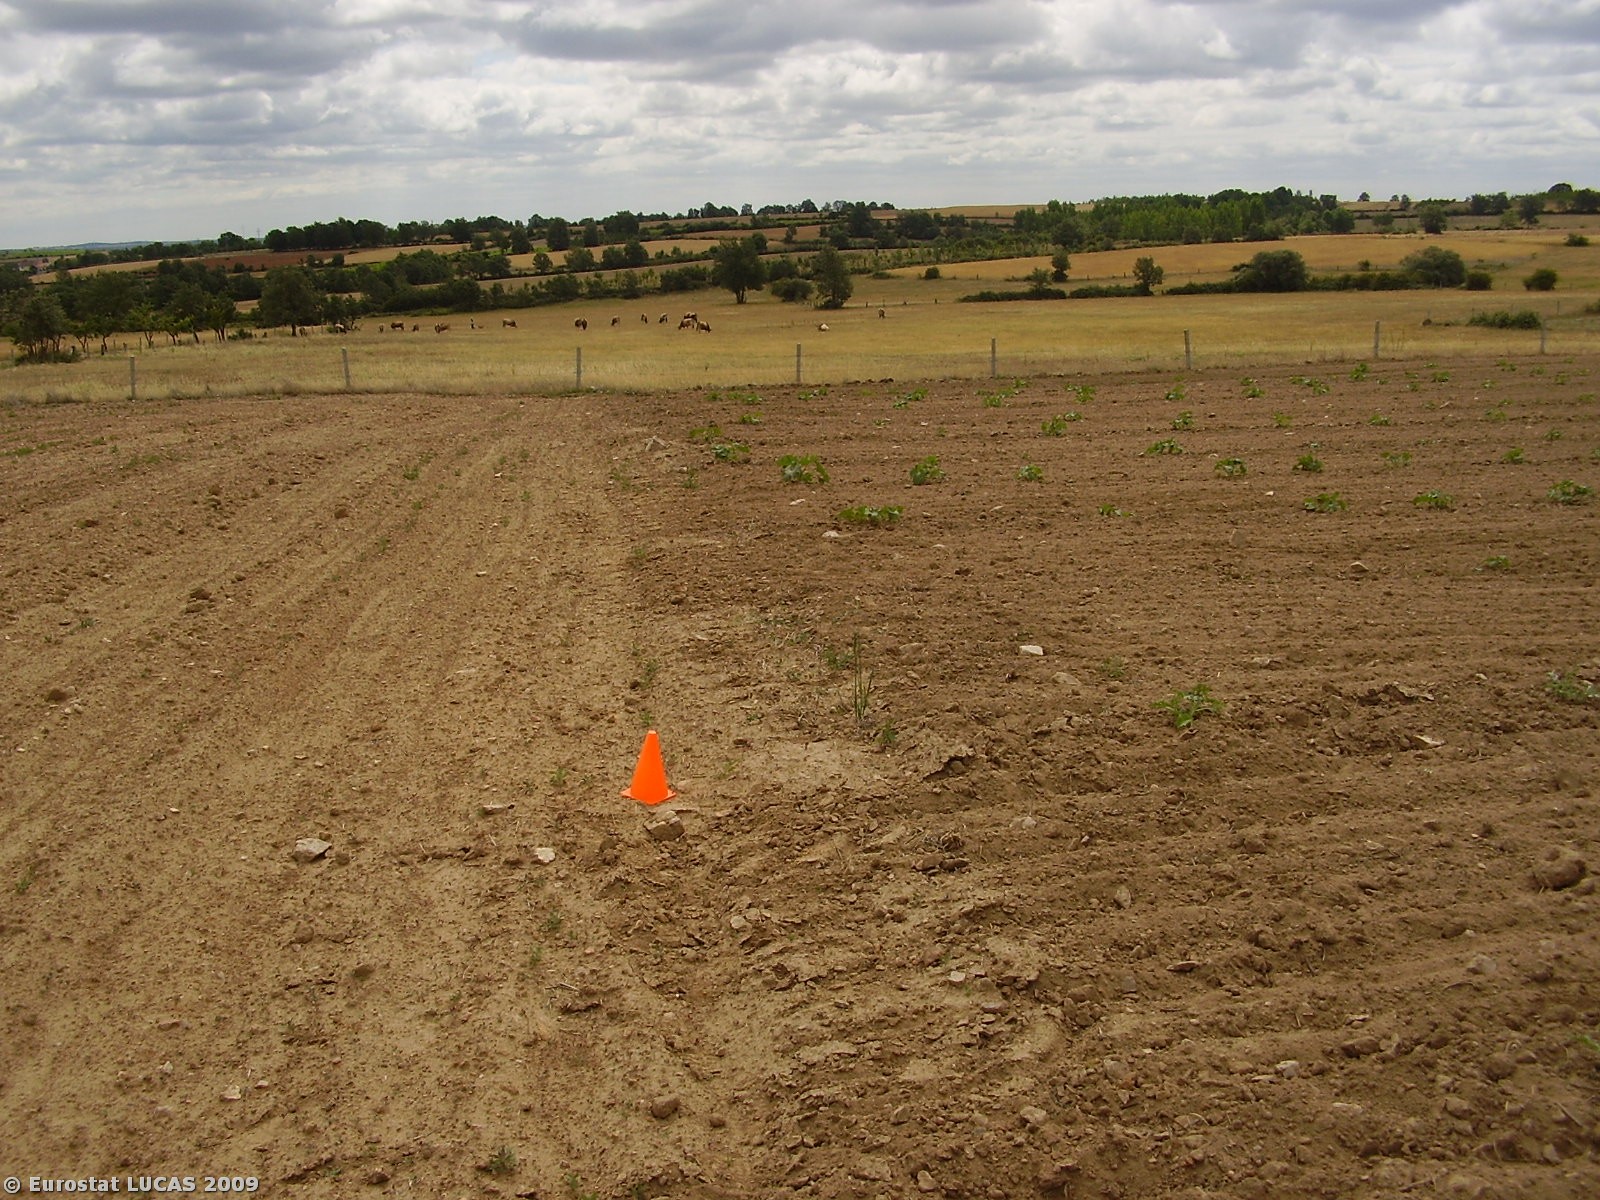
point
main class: Cropland
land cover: Other fresh vegetables
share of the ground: < 10 %
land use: Agriculture (excluding fallow land and kitchen gardens)
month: June
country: PT
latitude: 41.5371
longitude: -6.3411
